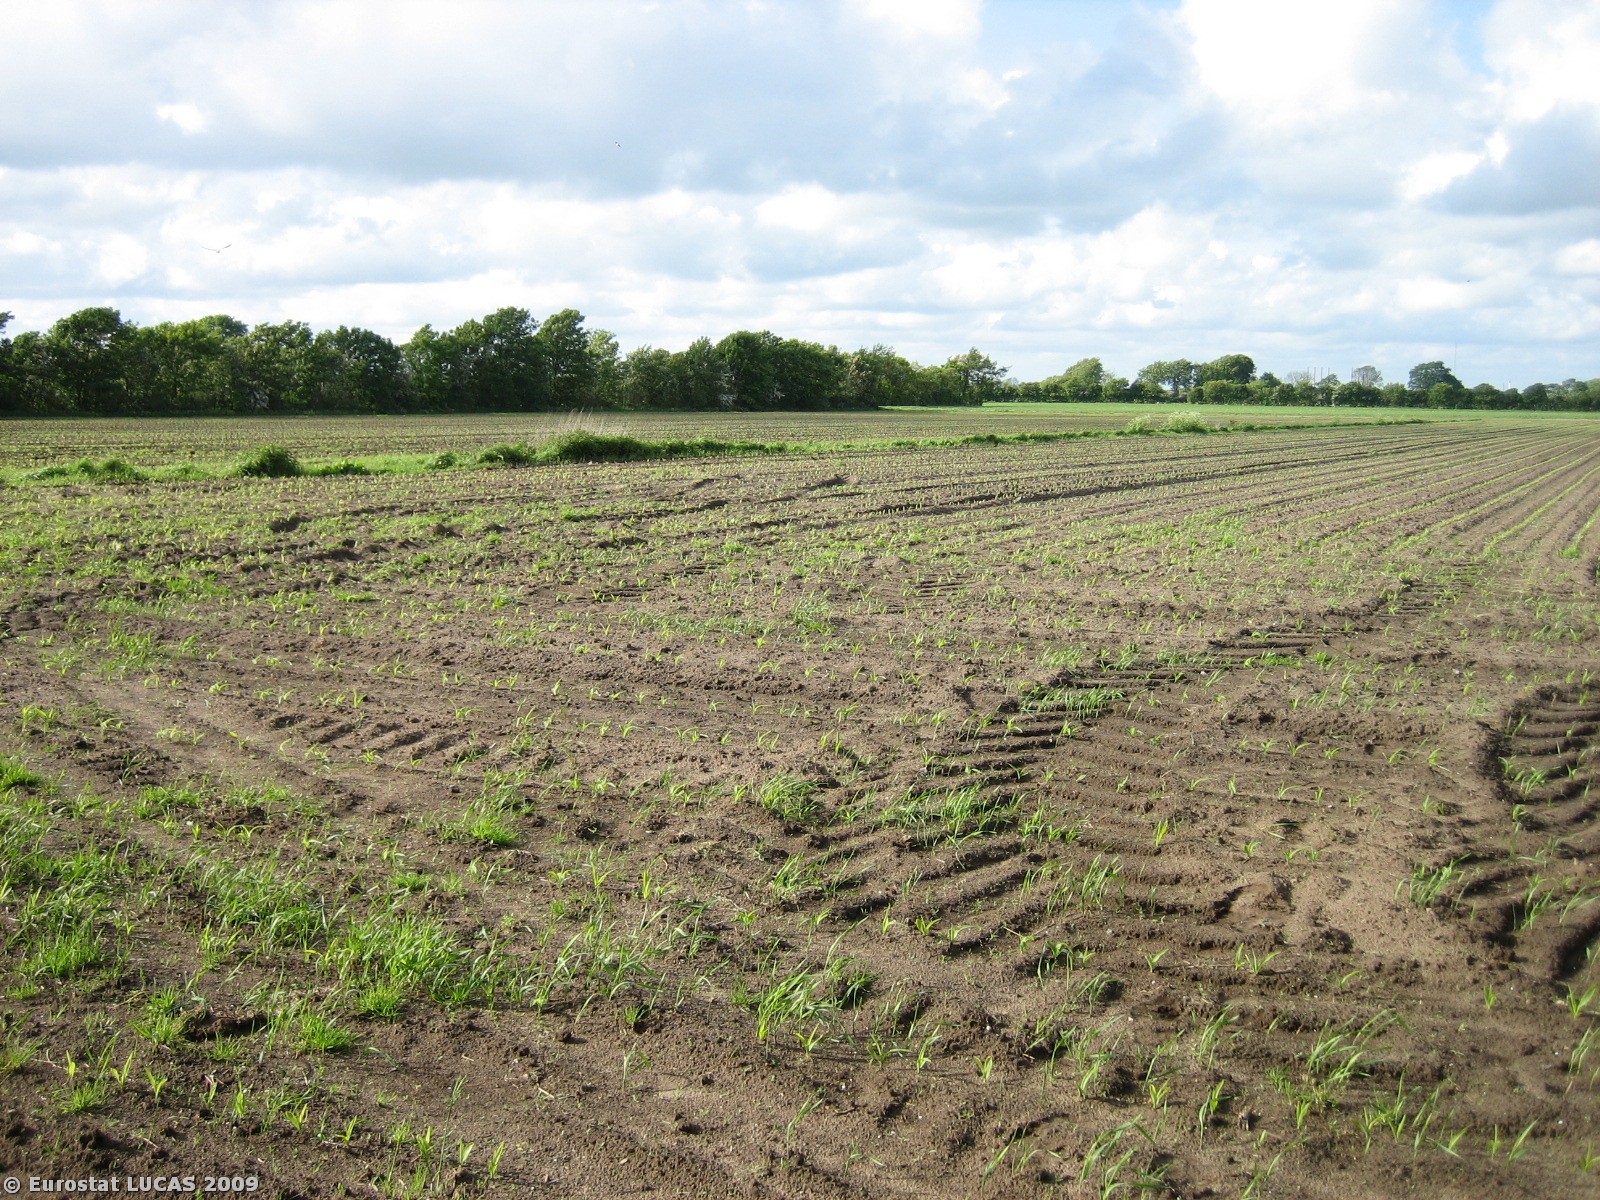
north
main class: Cropland
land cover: Maize
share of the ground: < 10 %
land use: Agriculture (excluding fallow land and kitchen gardens)
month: May
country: DK
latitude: 56.0934
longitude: 8.9243
